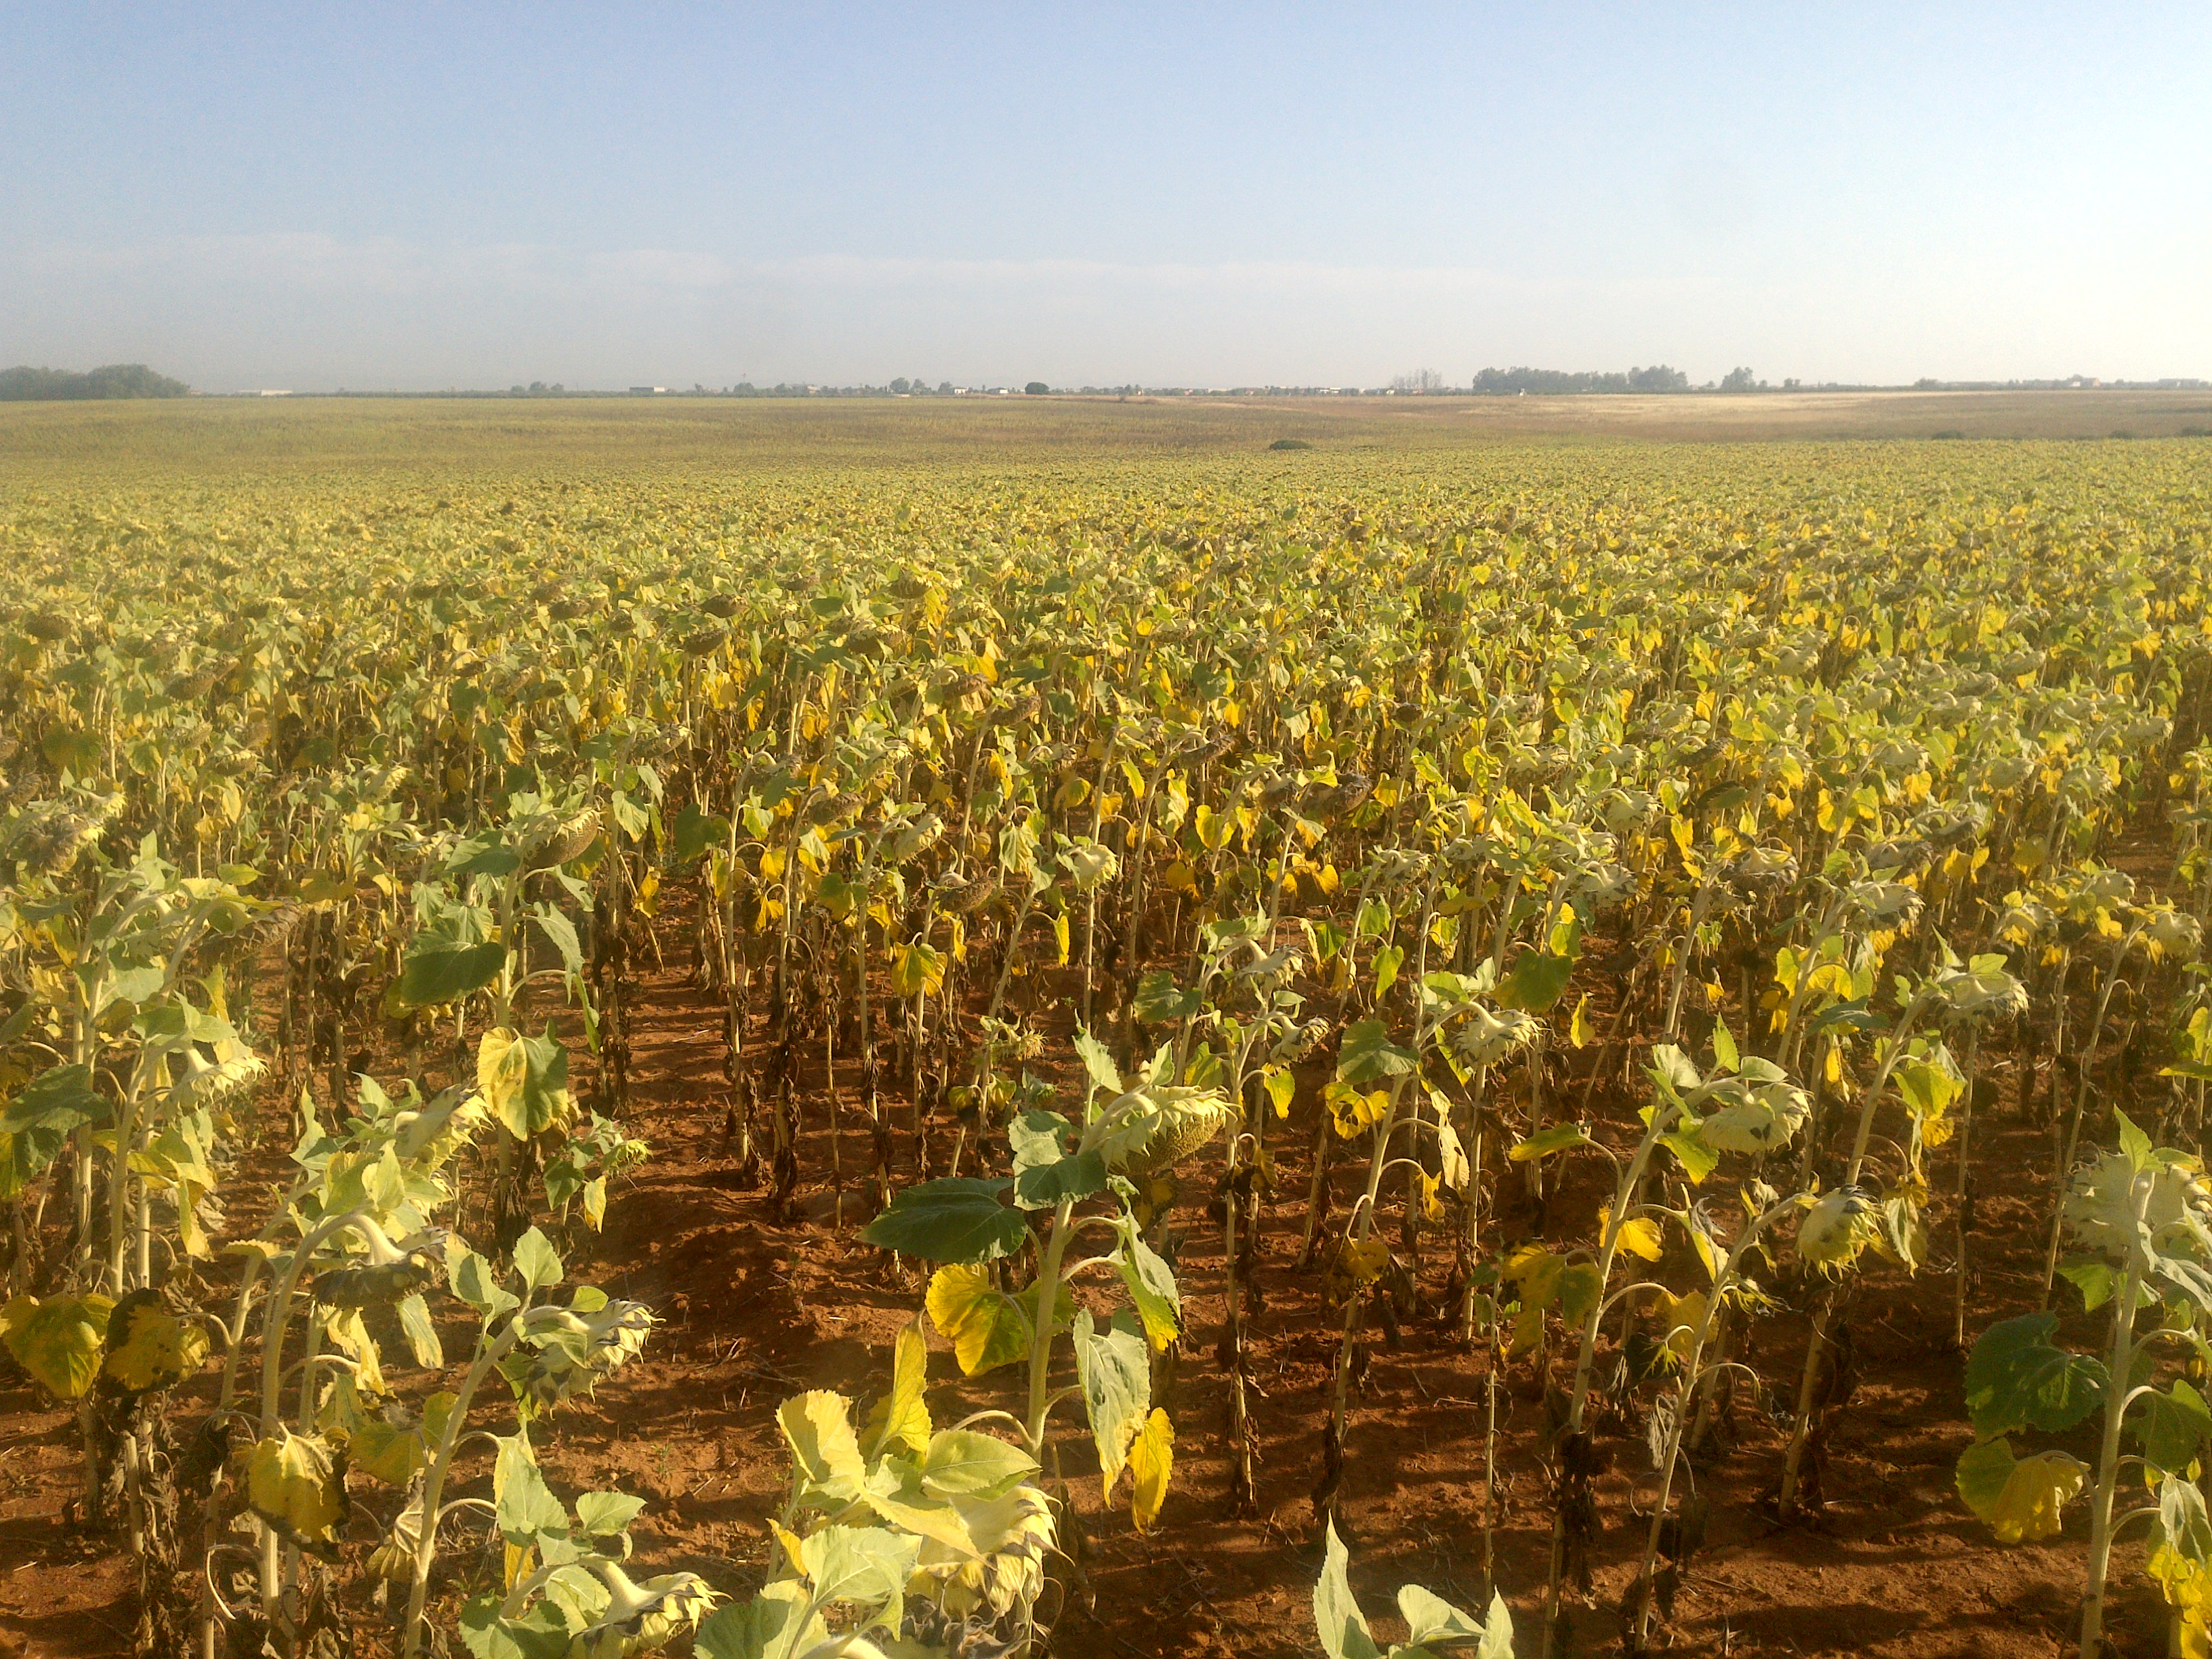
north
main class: Cropland
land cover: Sunflower
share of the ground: > 75 %
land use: Agriculture (excluding fallow land and kitchen gardens)
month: June
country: ES
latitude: 37.6459
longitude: -4.9389
